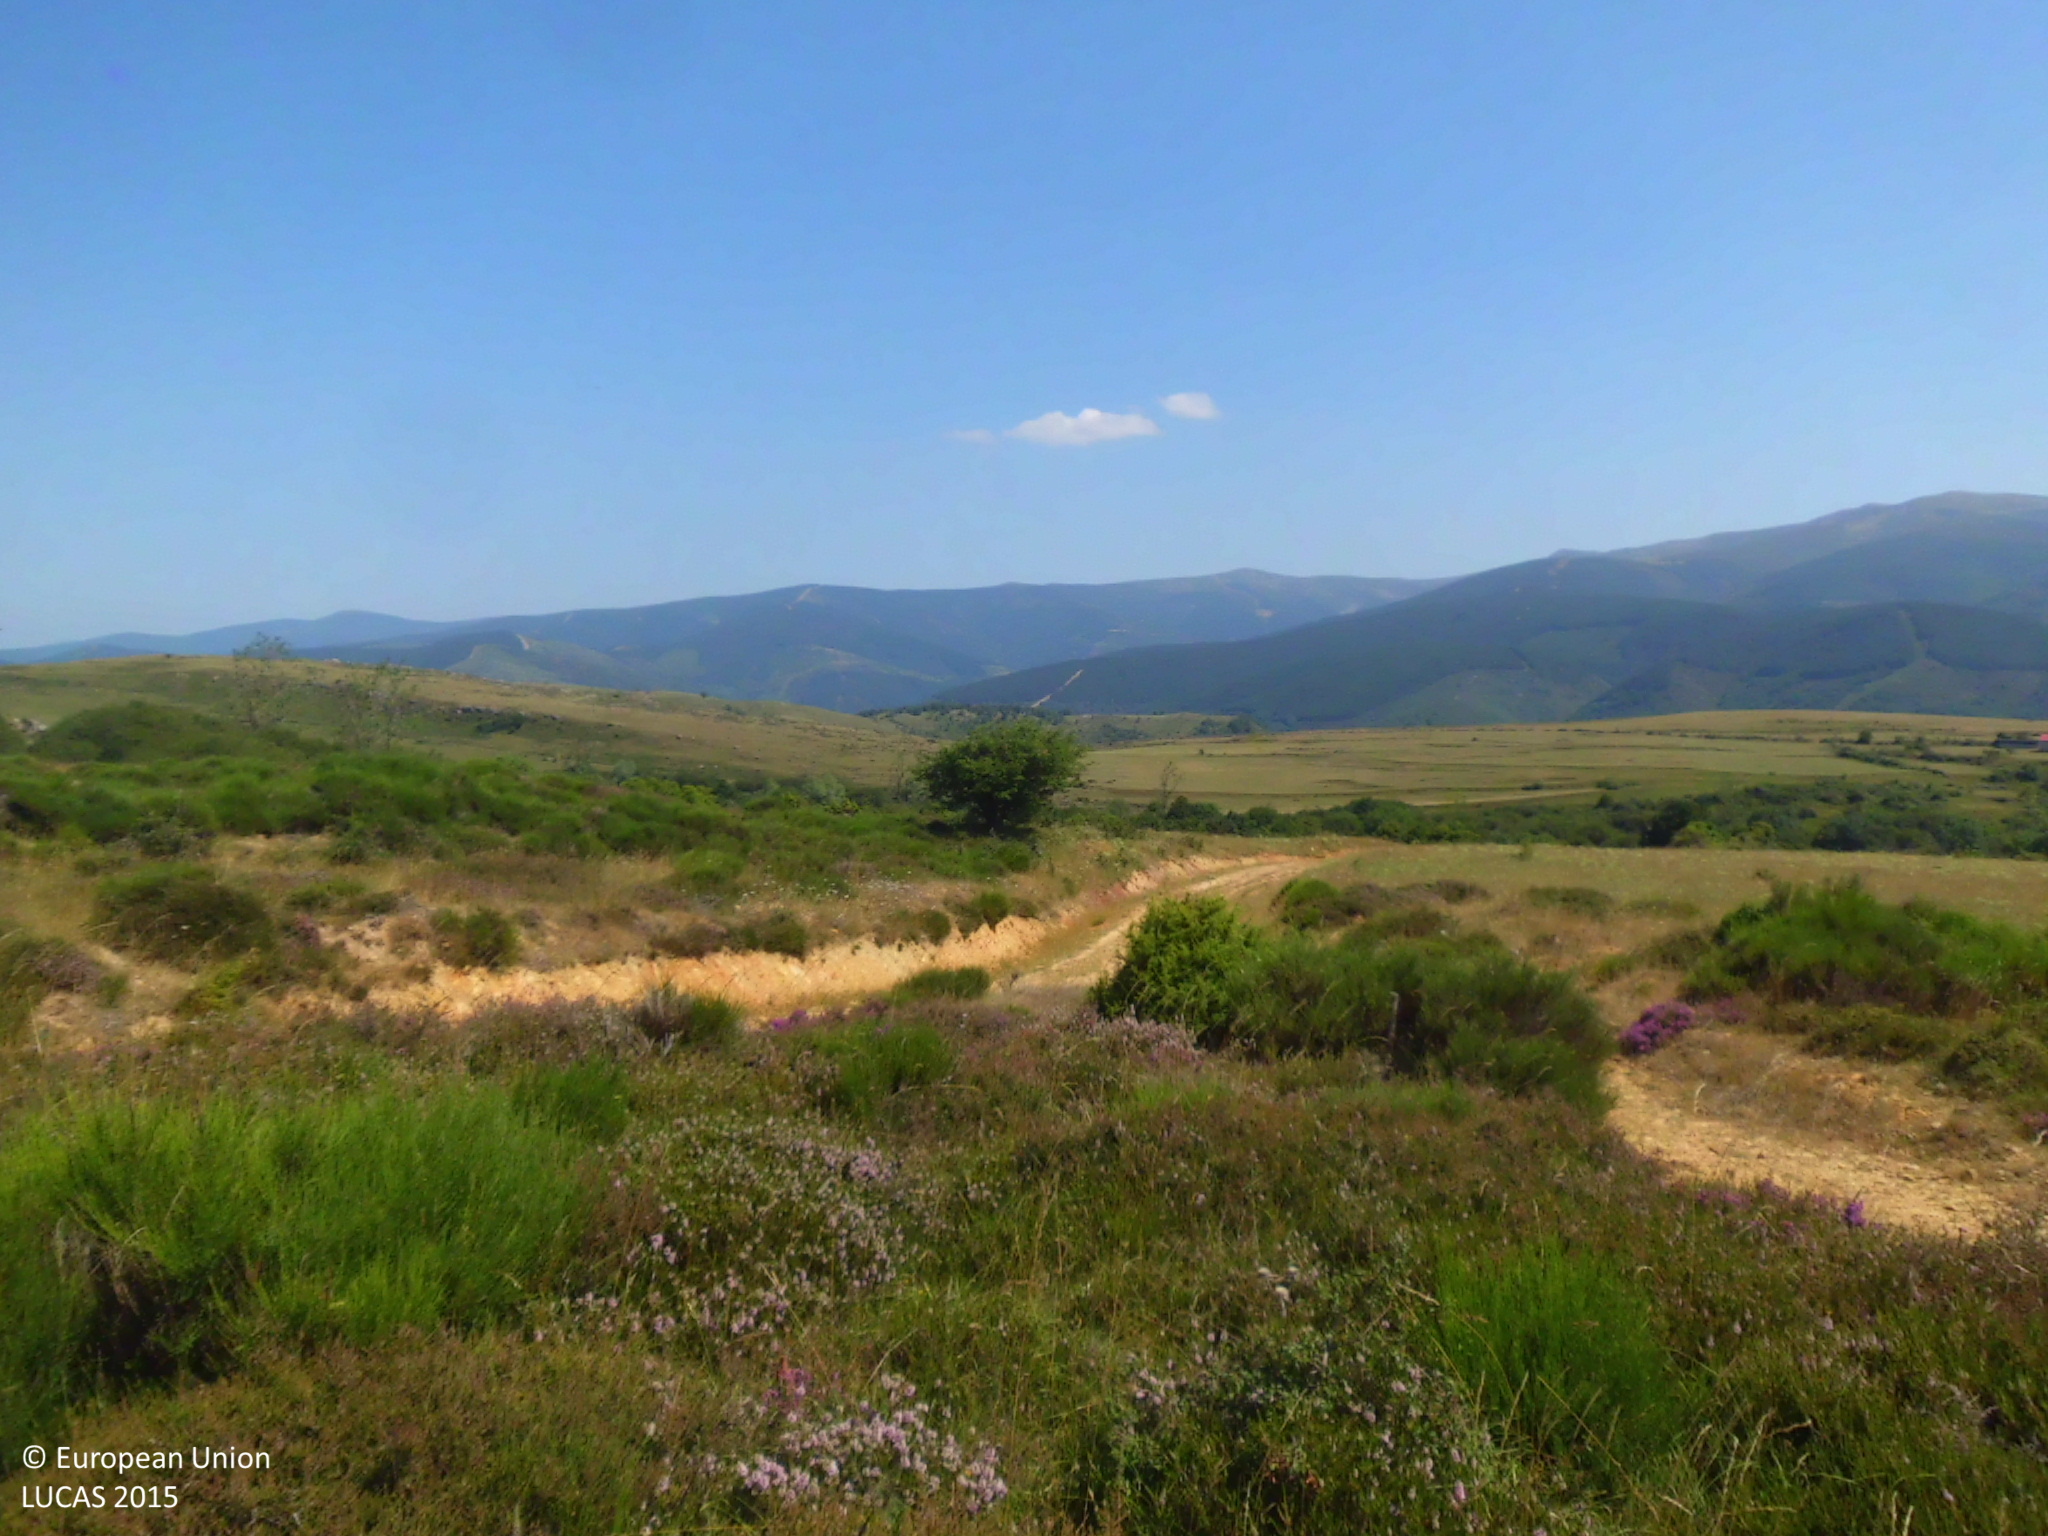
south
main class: Shrubland
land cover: Shrubland without tree cover
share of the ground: 50 - 75 %
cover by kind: shrubs 60 %, herbaceous plants 40 %
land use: Semi-natural and natural areas not in use
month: July
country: ES
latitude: 42.3251
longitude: -3.2688
